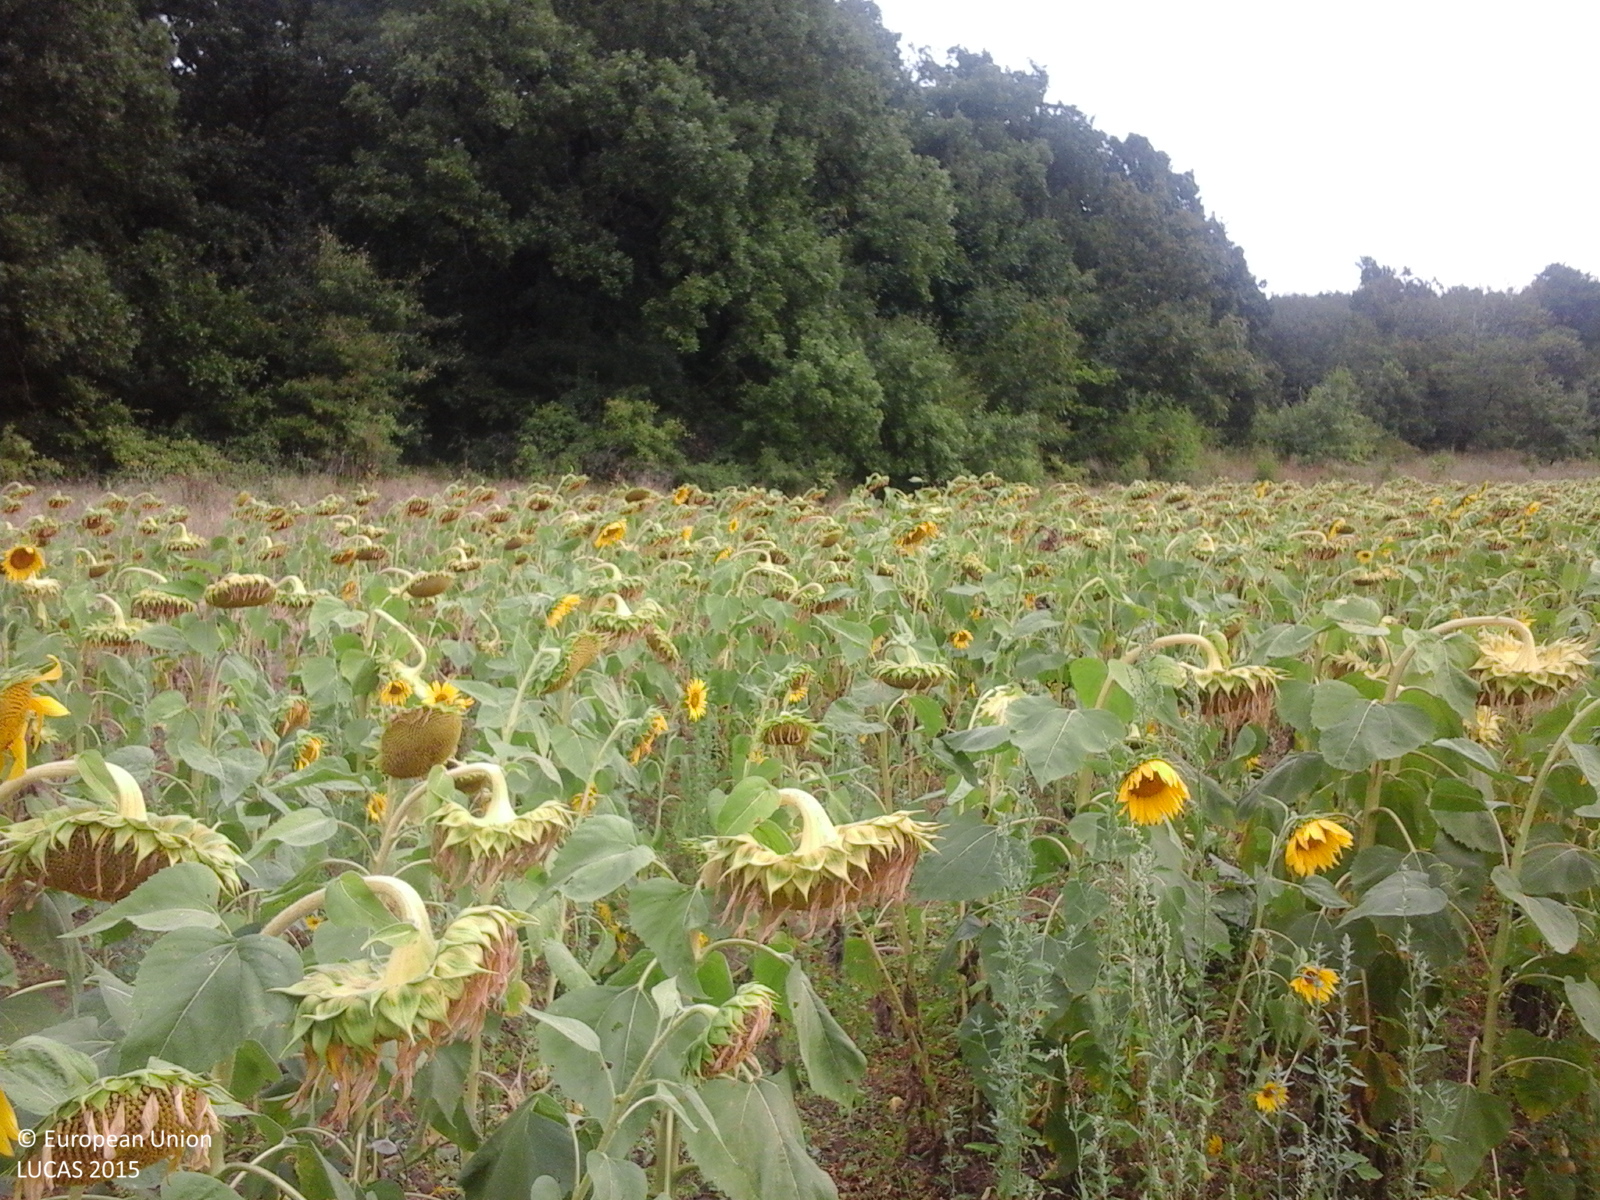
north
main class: Cropland
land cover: Sunflower
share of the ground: > 75 %
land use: Agriculture (excluding fallow land and kitchen gardens)
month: August
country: RO
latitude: 44.8587
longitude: 28.6462
